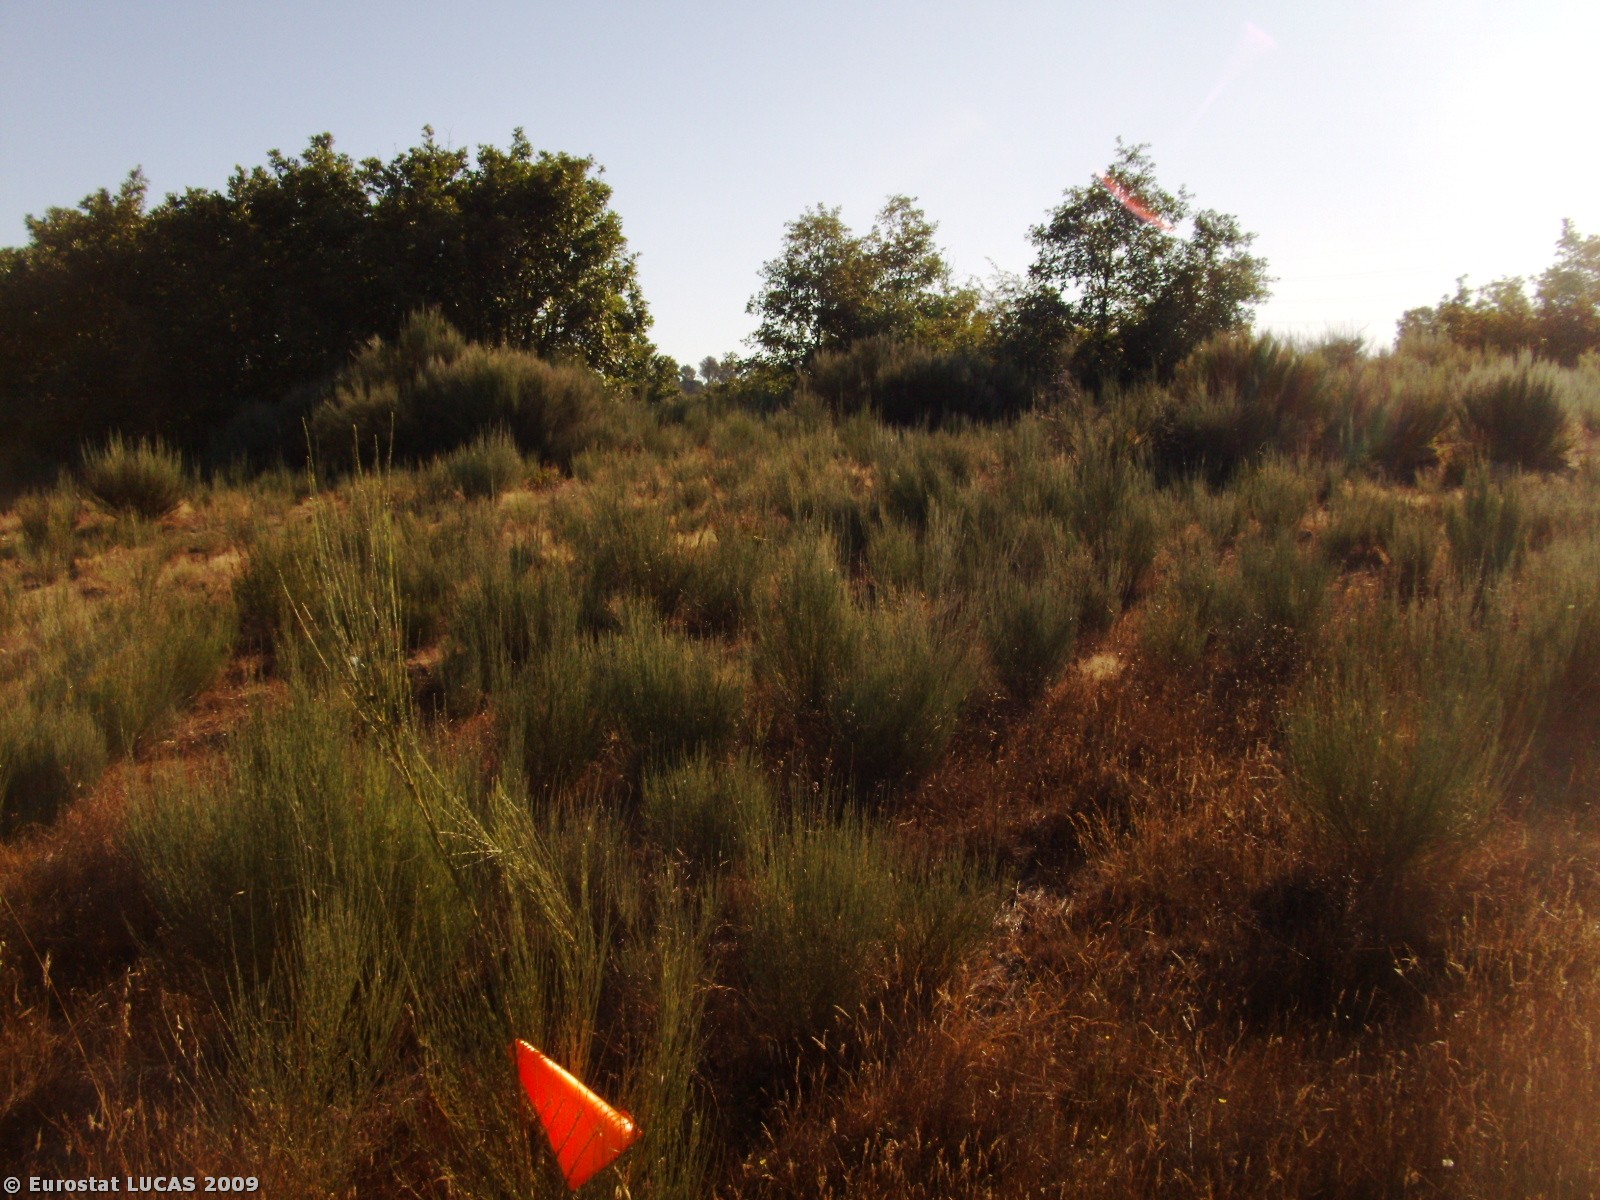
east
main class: Shrubland
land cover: Shrubland with sparse tree cover
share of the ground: > 75 %
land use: Fallow land
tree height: > 5 m
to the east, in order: Shrubland with sparse tree cover; Coniferous woodland; Broadleaved woodland
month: July
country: PT
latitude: 40.3064
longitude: -7.3892
